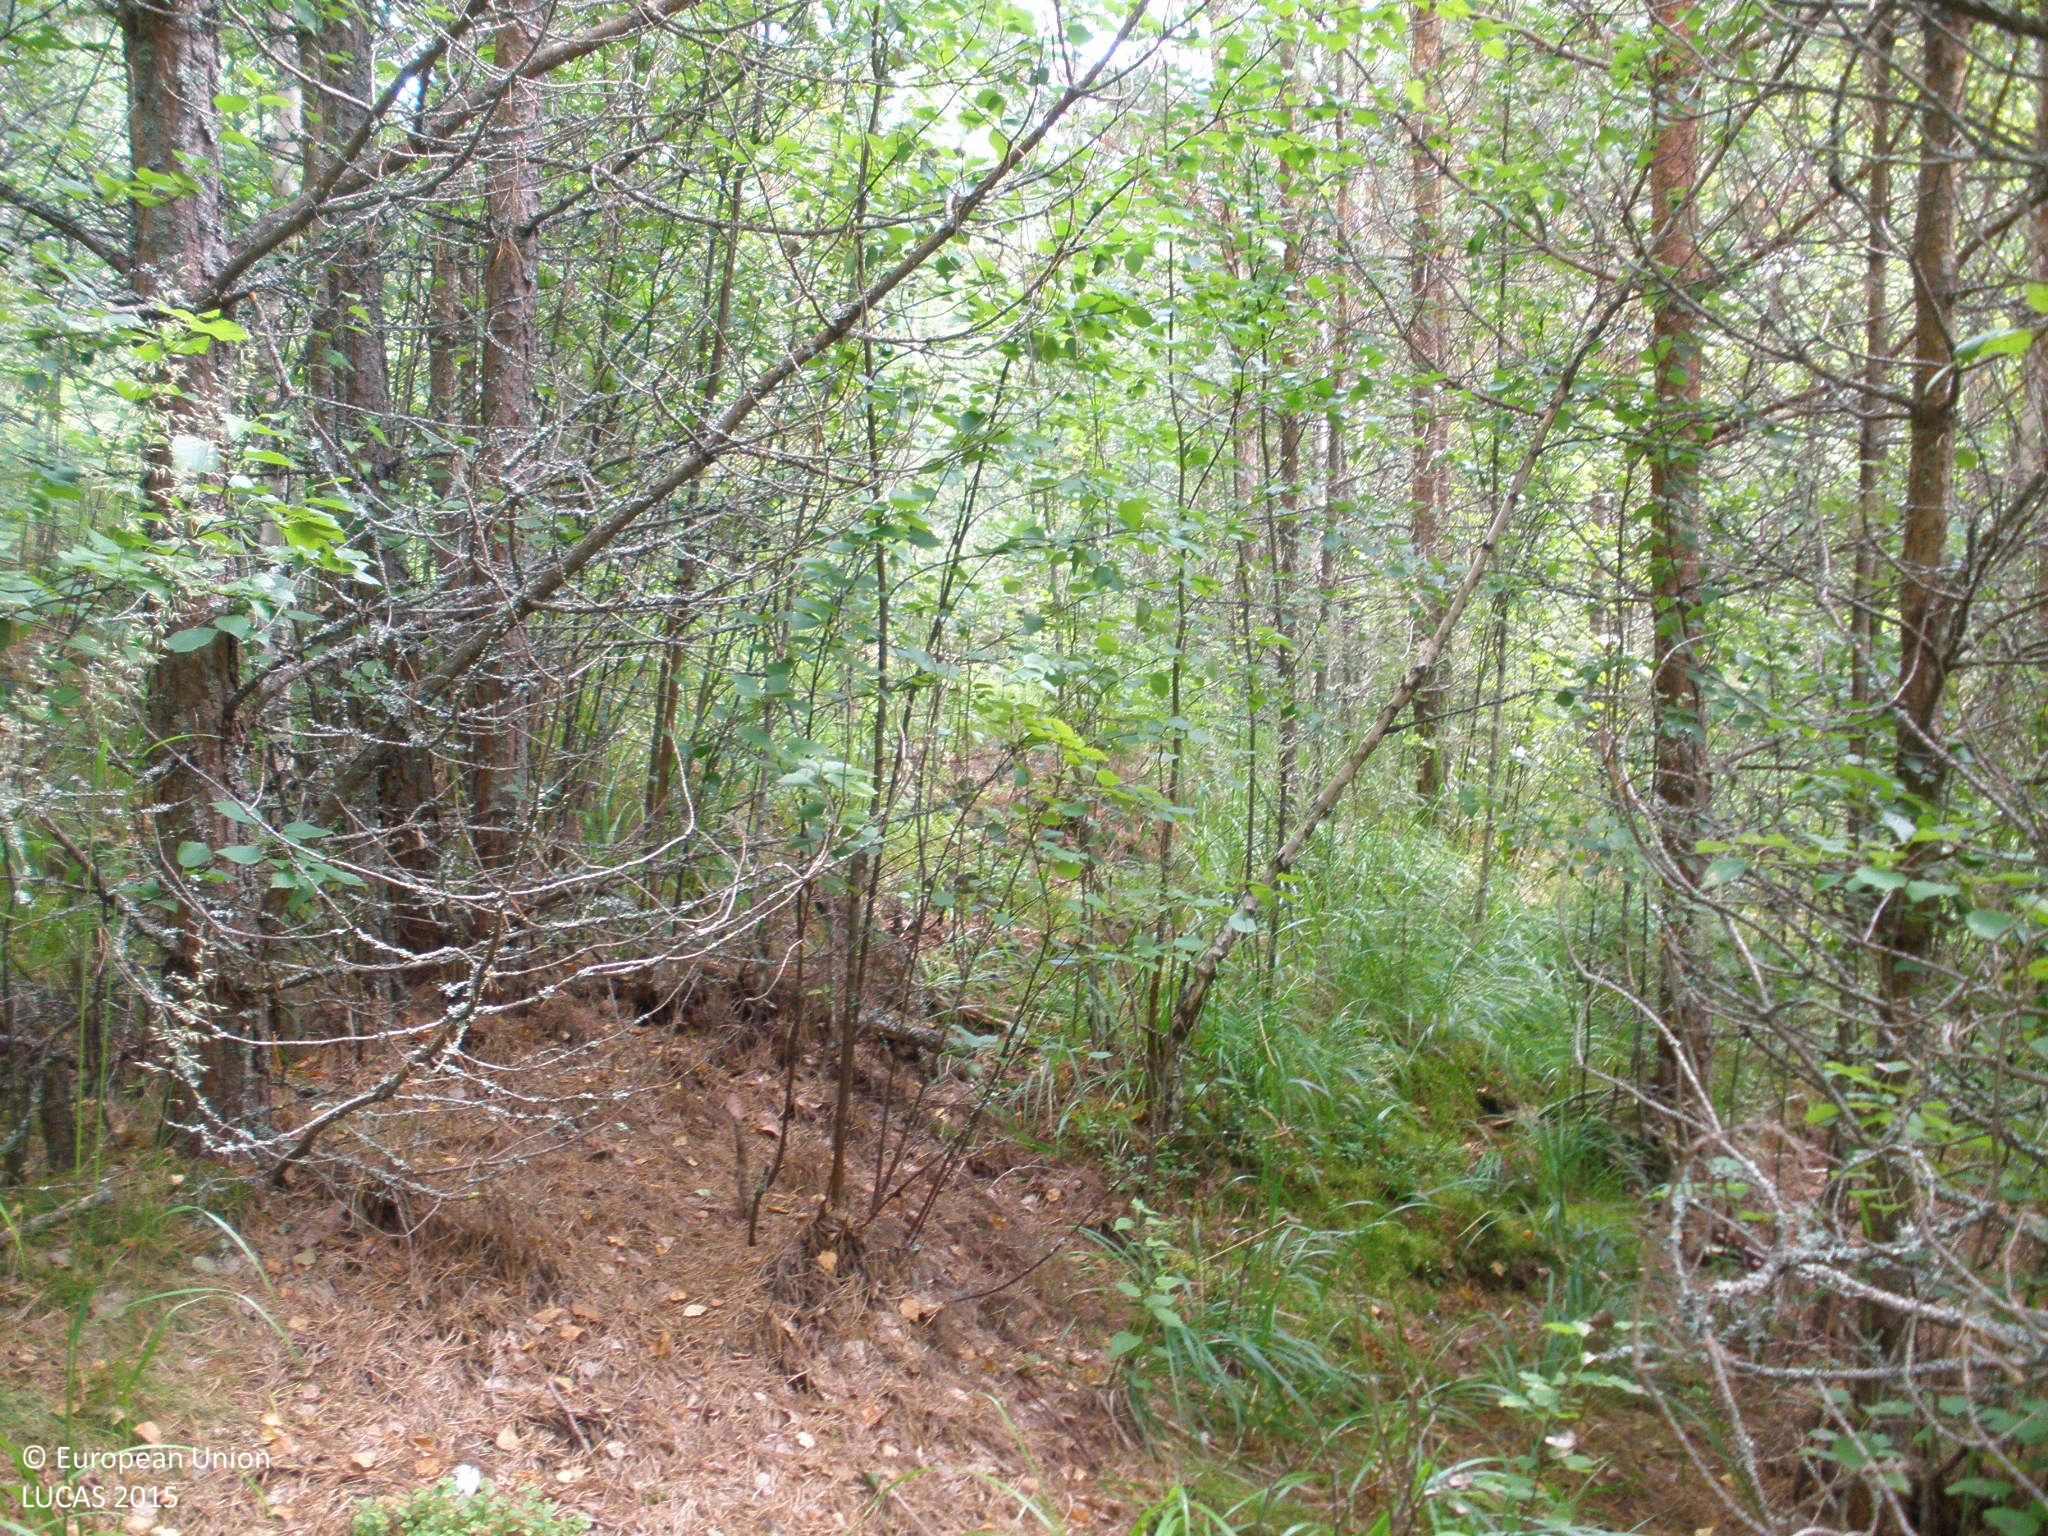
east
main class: Woodland
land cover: Pine dominated mixed woodland
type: boreal forest
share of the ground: > 75 %
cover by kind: coniferous forest trees 60 %, broadleaved forest trees 25 %, herbaceous plants 10 %, lichens and mosses 5 %
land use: Forestry
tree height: > 5 m
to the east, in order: Pine dominated mixed woodland; Other mixed woodland; Pine dominated mixed woodland; Tracks; Ditches and canals; Other mixed woodland; Ditches and canals; Other mixed woodland
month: August
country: FI
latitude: 60.6280
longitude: 24.2283
